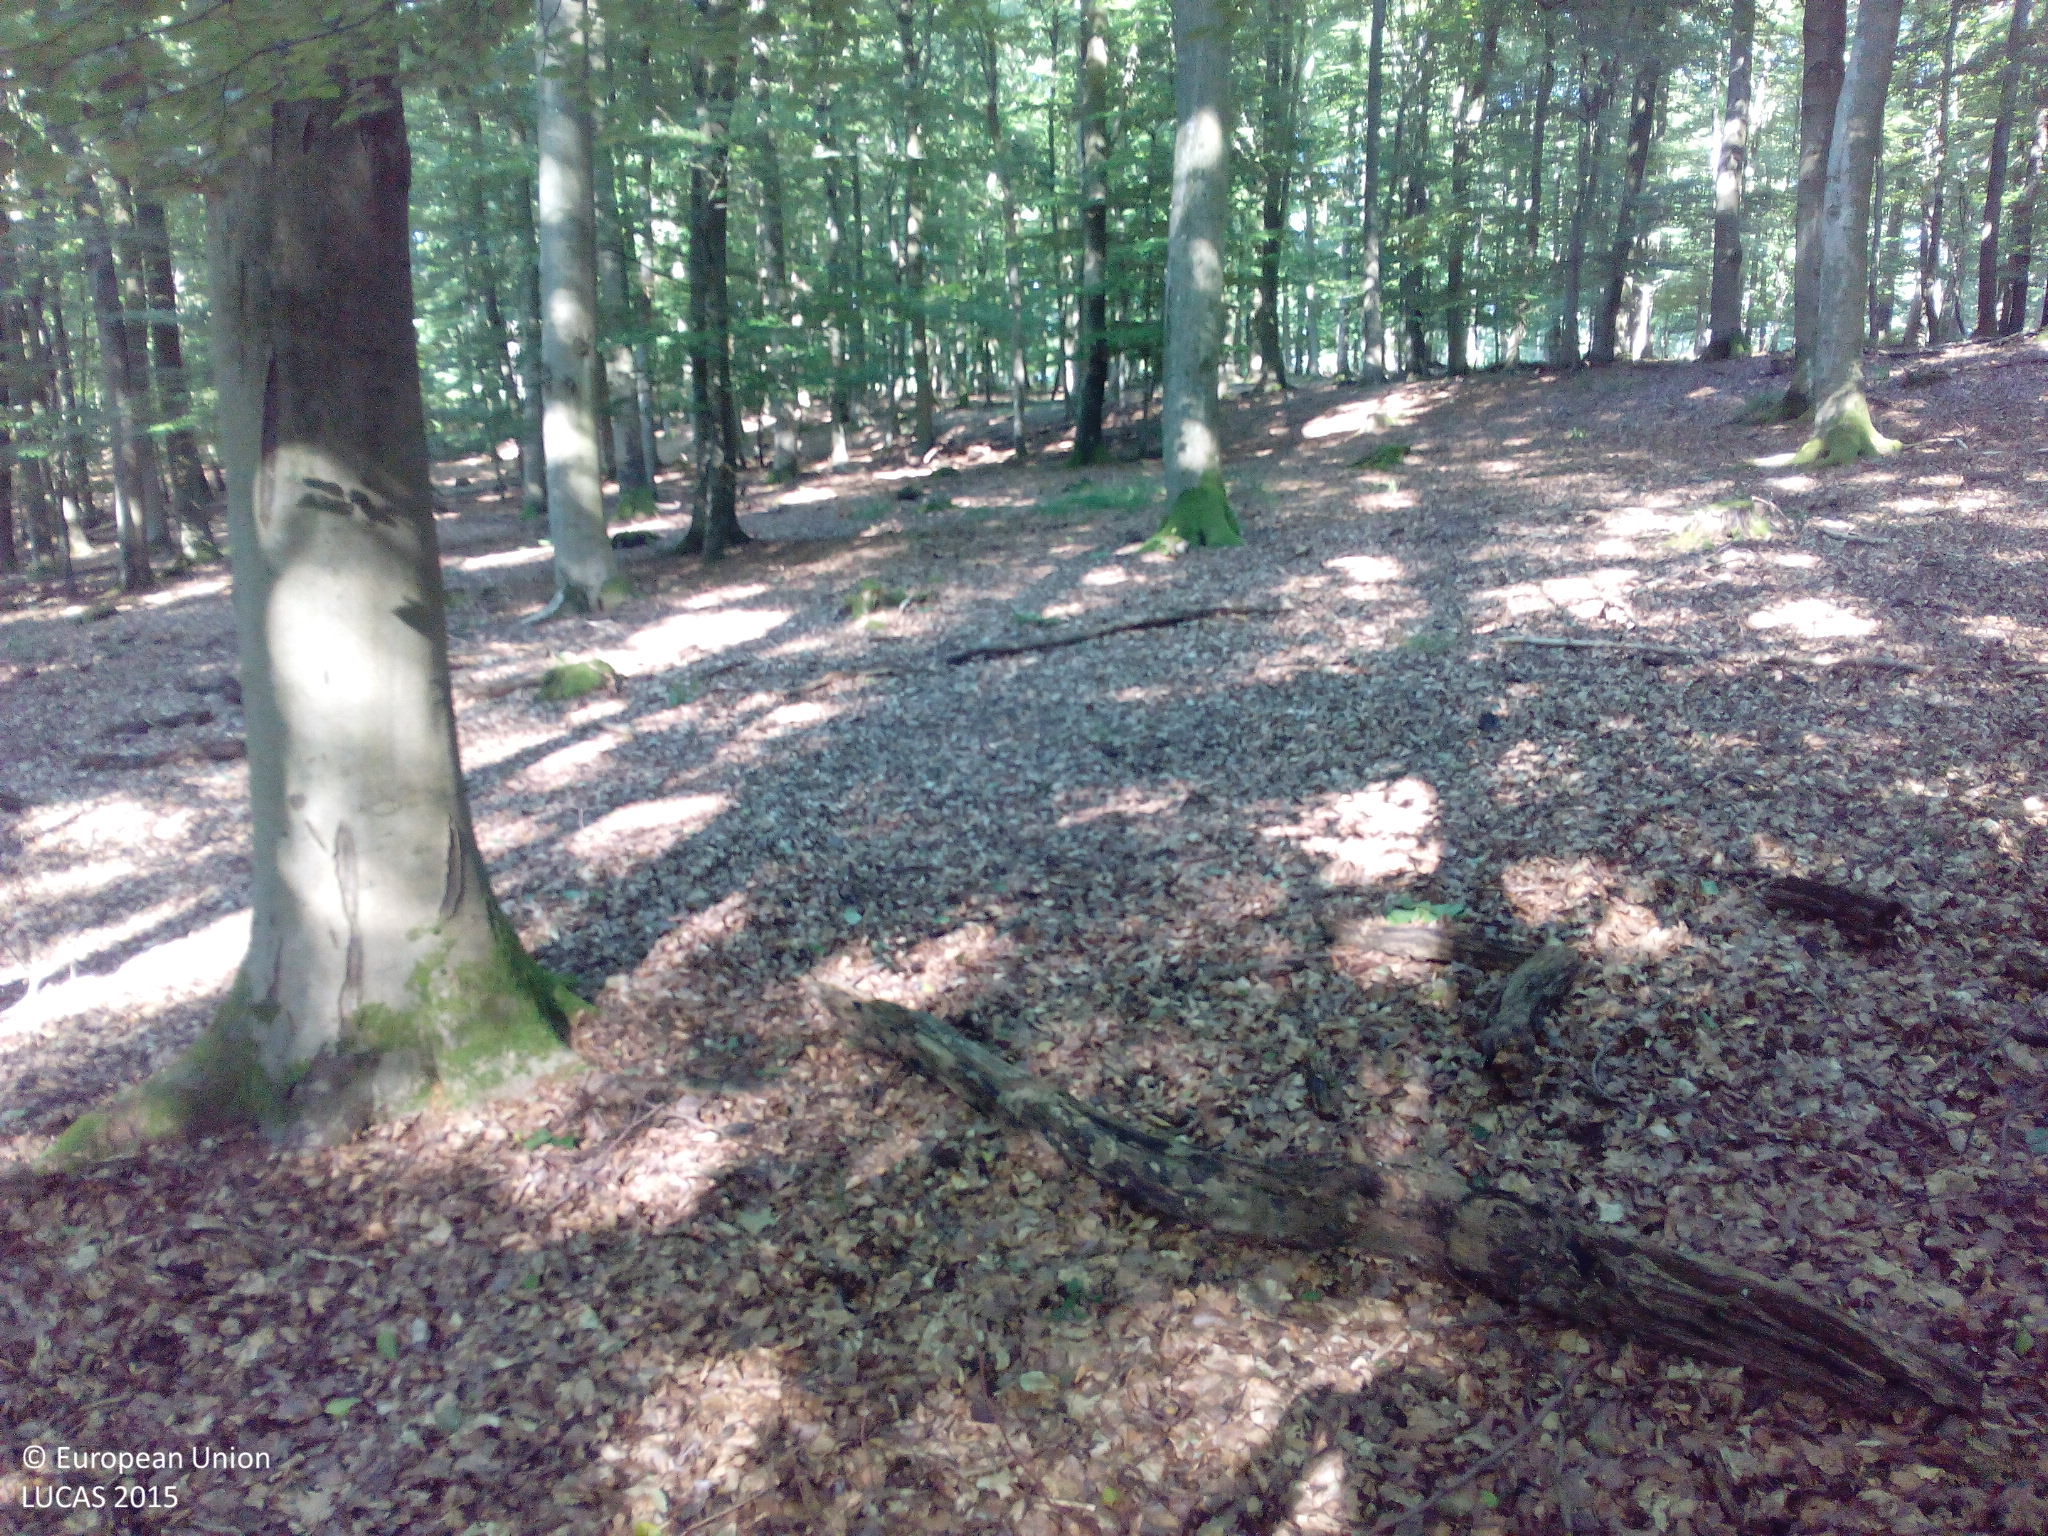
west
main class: Woodland
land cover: Broadleaved woodland
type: beech forest
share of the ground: > 75 %
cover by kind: broadleaved forest trees 100 %
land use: Forestry
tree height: > 5 m
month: July
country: DE
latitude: 49.9512
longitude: 7.1710
